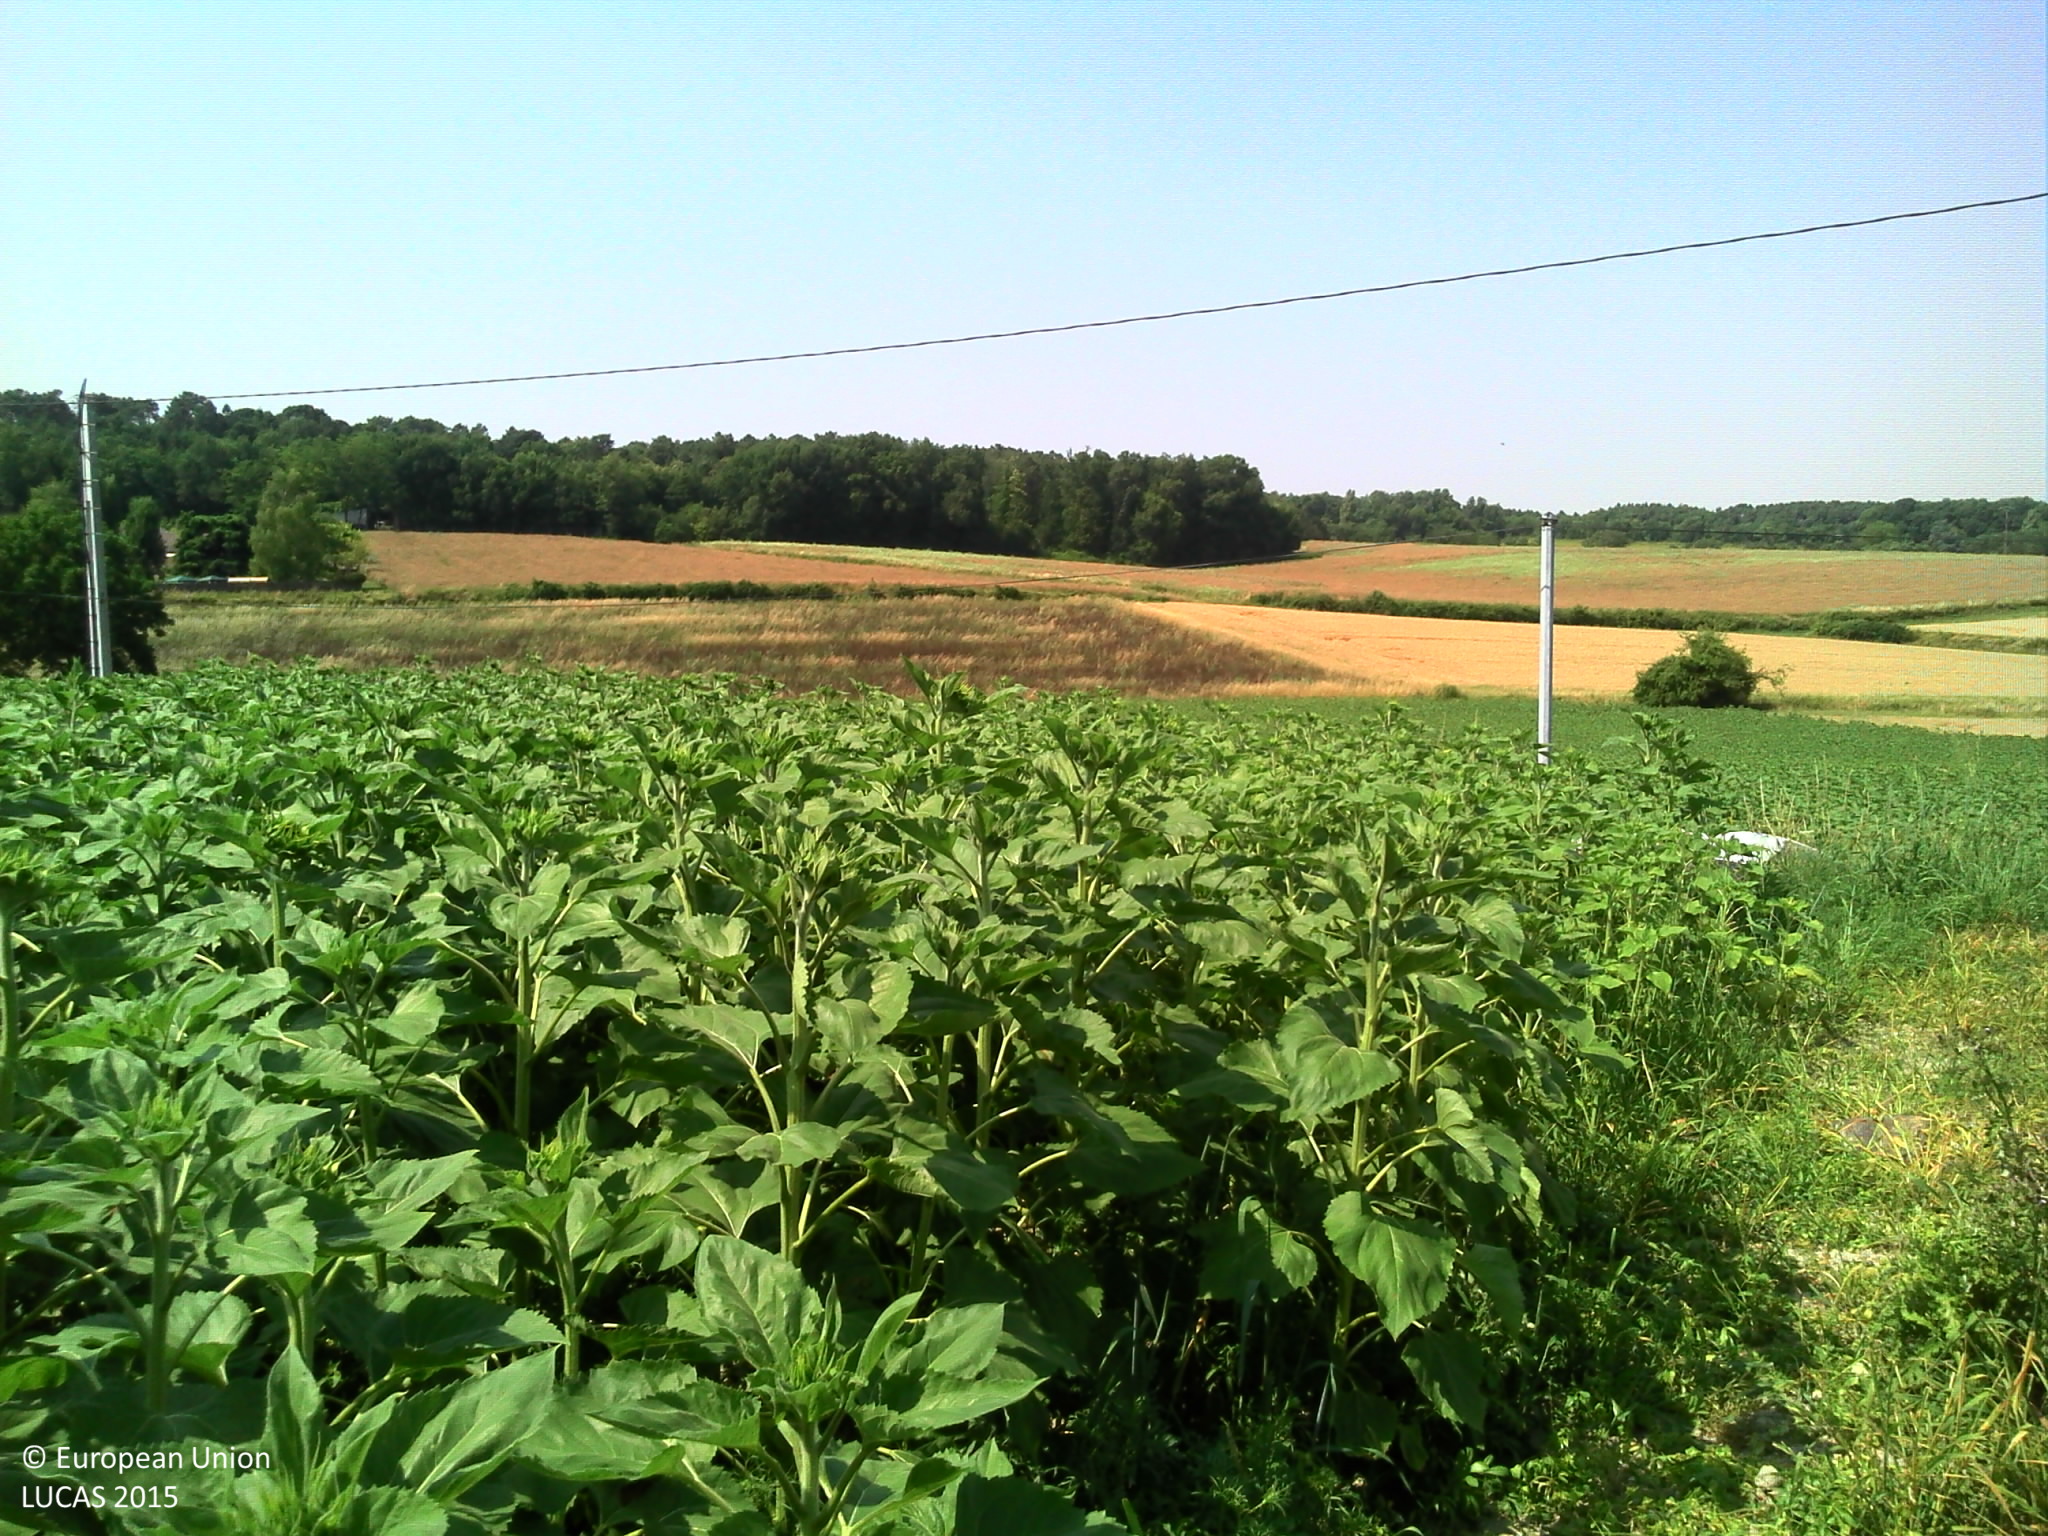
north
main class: Cropland
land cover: Sunflower
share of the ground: > 75 %
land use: Agriculture (excluding fallow land and kitchen gardens)
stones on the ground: < 10 %
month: July
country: FR
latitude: 46.8496
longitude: 0.4729
